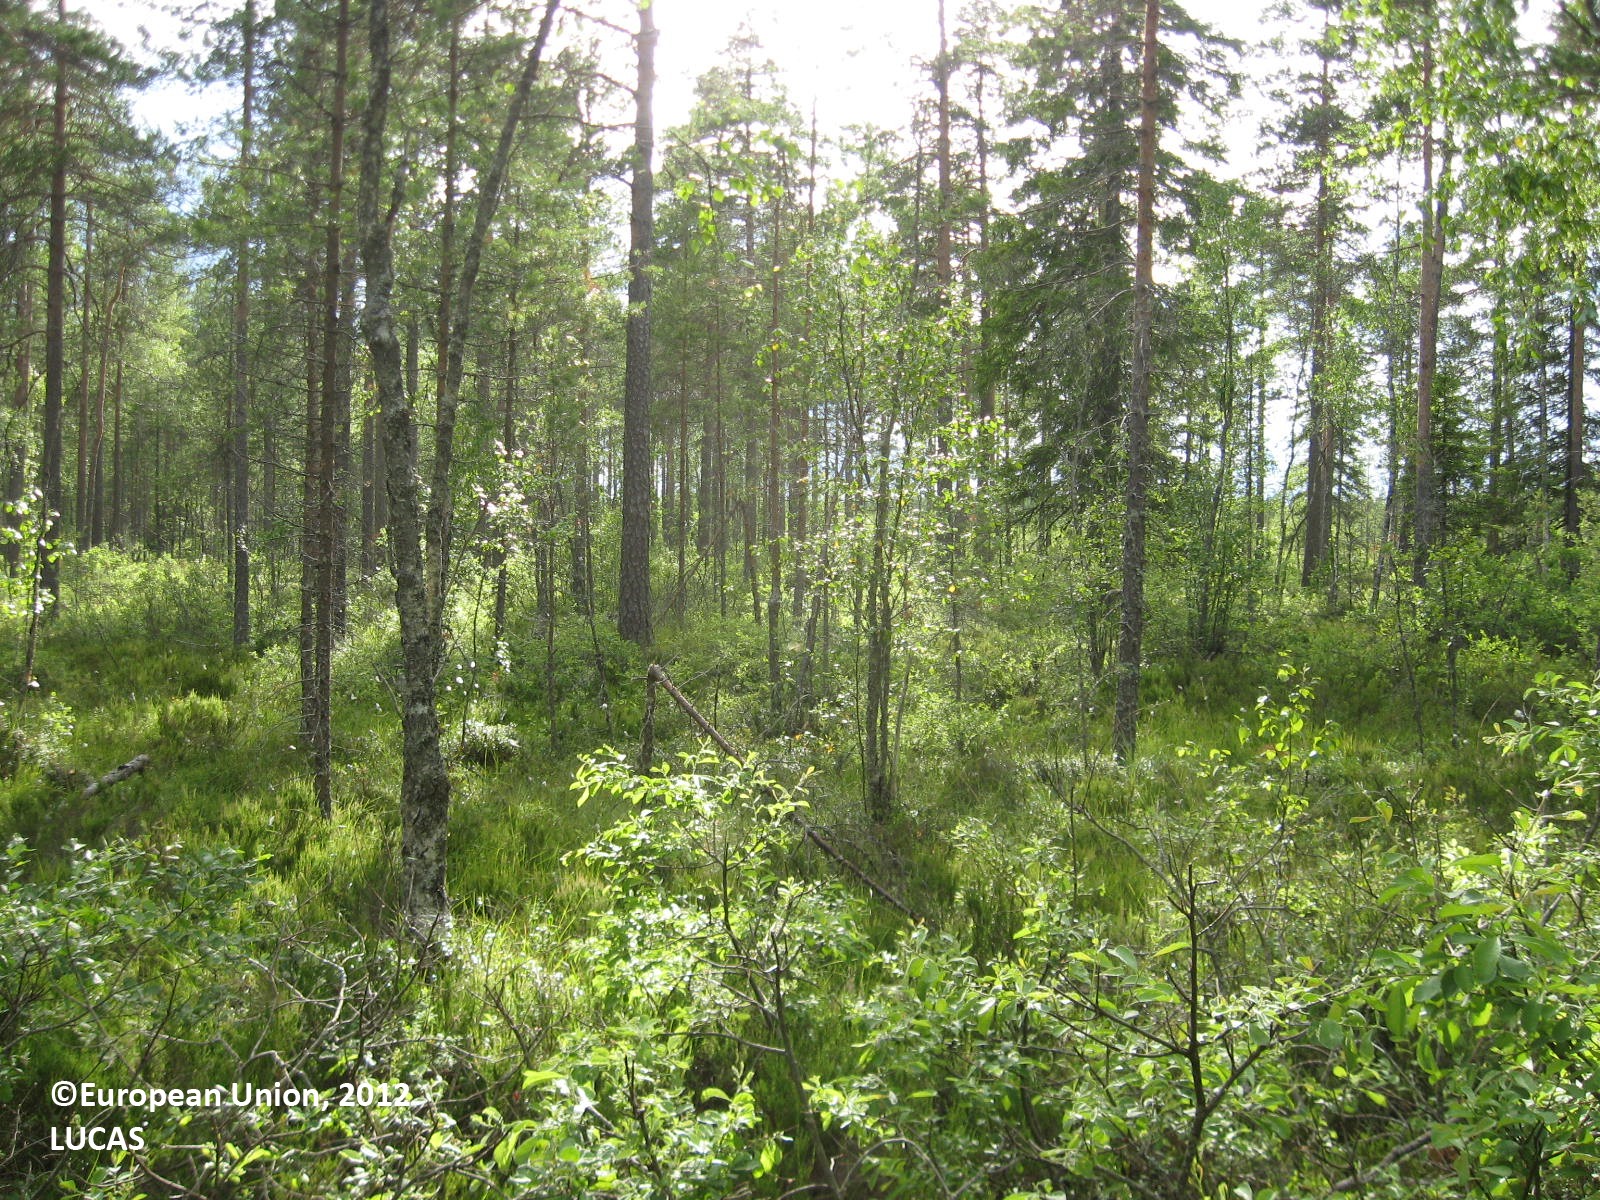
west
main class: Woodland
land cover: Pine dominated mixed woodland
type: boreal forest
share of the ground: > 75 %
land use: Forestry
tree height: > 5 m
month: July
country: FI
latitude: 62.1495
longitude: 22.4338
